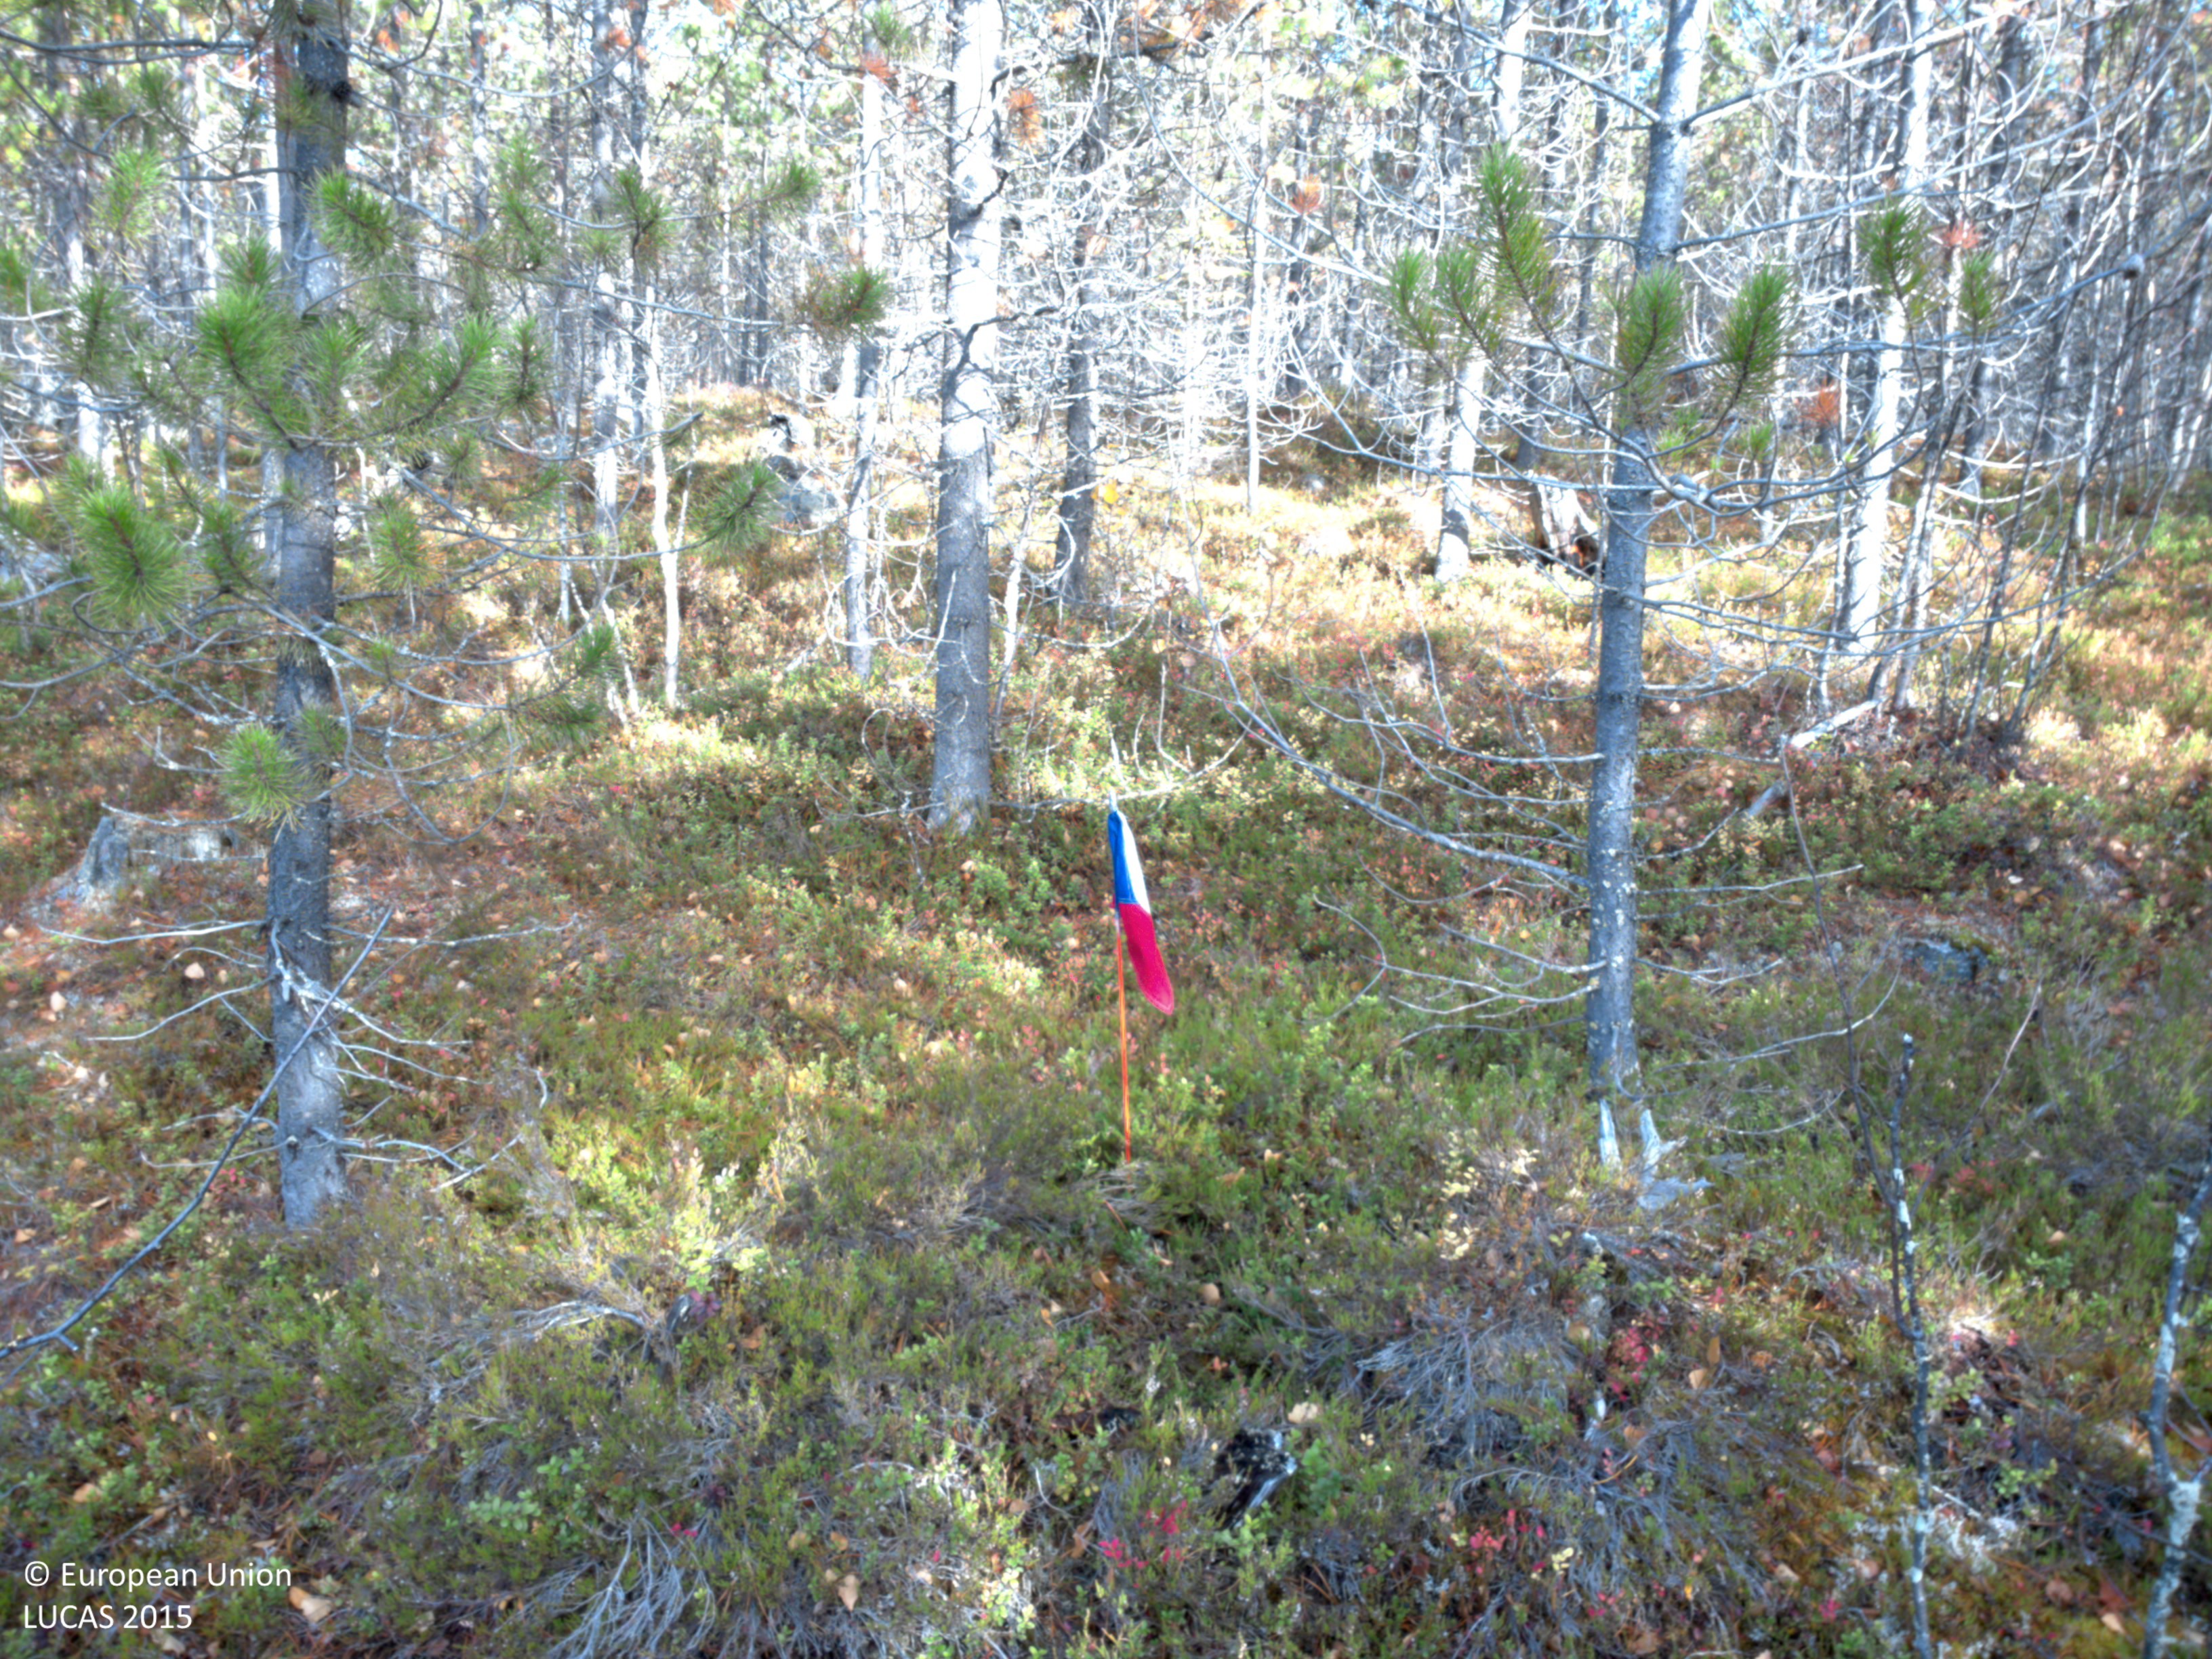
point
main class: Woodland
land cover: Pine dominated coniferous woodland
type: exotic forest
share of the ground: > 75 %
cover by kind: coniferous forest trees 75 %, shrubs 15 %, lichens and mosses 10 %
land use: Forestry
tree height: > 5 m
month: October
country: SE
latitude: 64.8067
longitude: 17.7763
